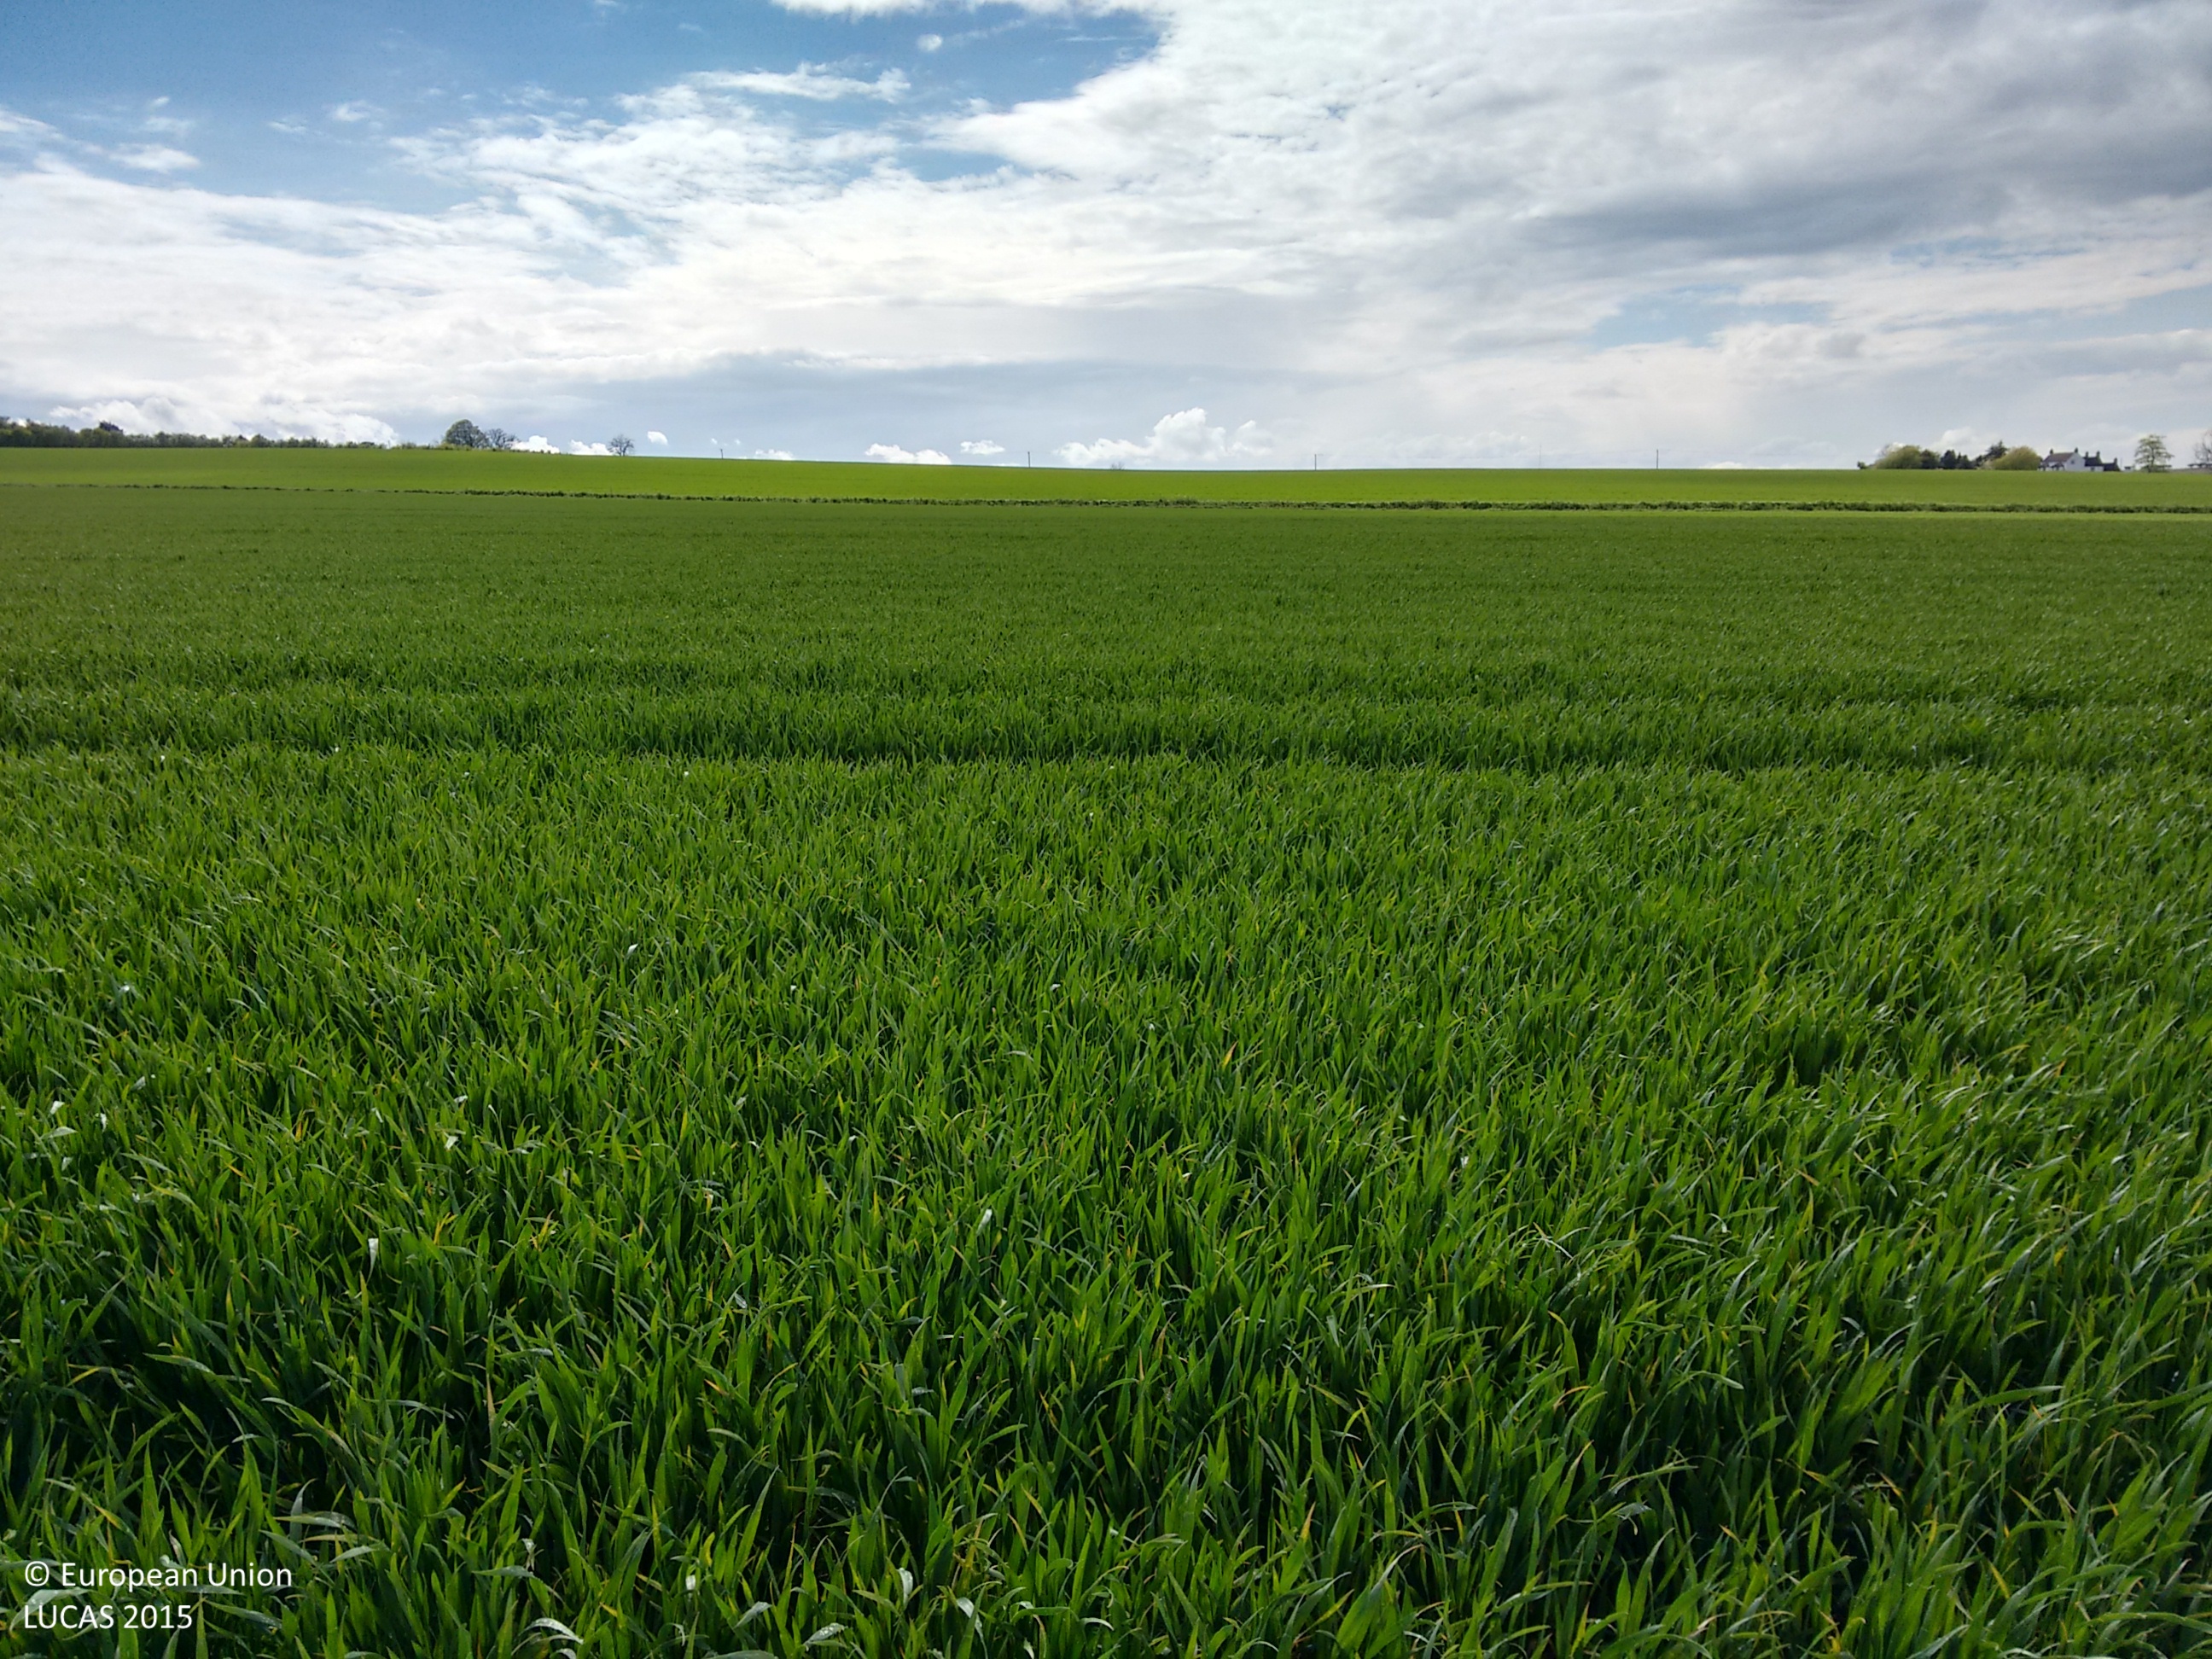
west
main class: Cropland
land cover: Common wheat
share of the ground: > 75 %
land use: Agriculture (excluding fallow land and kitchen gardens)
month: May
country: GB
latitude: 53.3501
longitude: 0.0083
